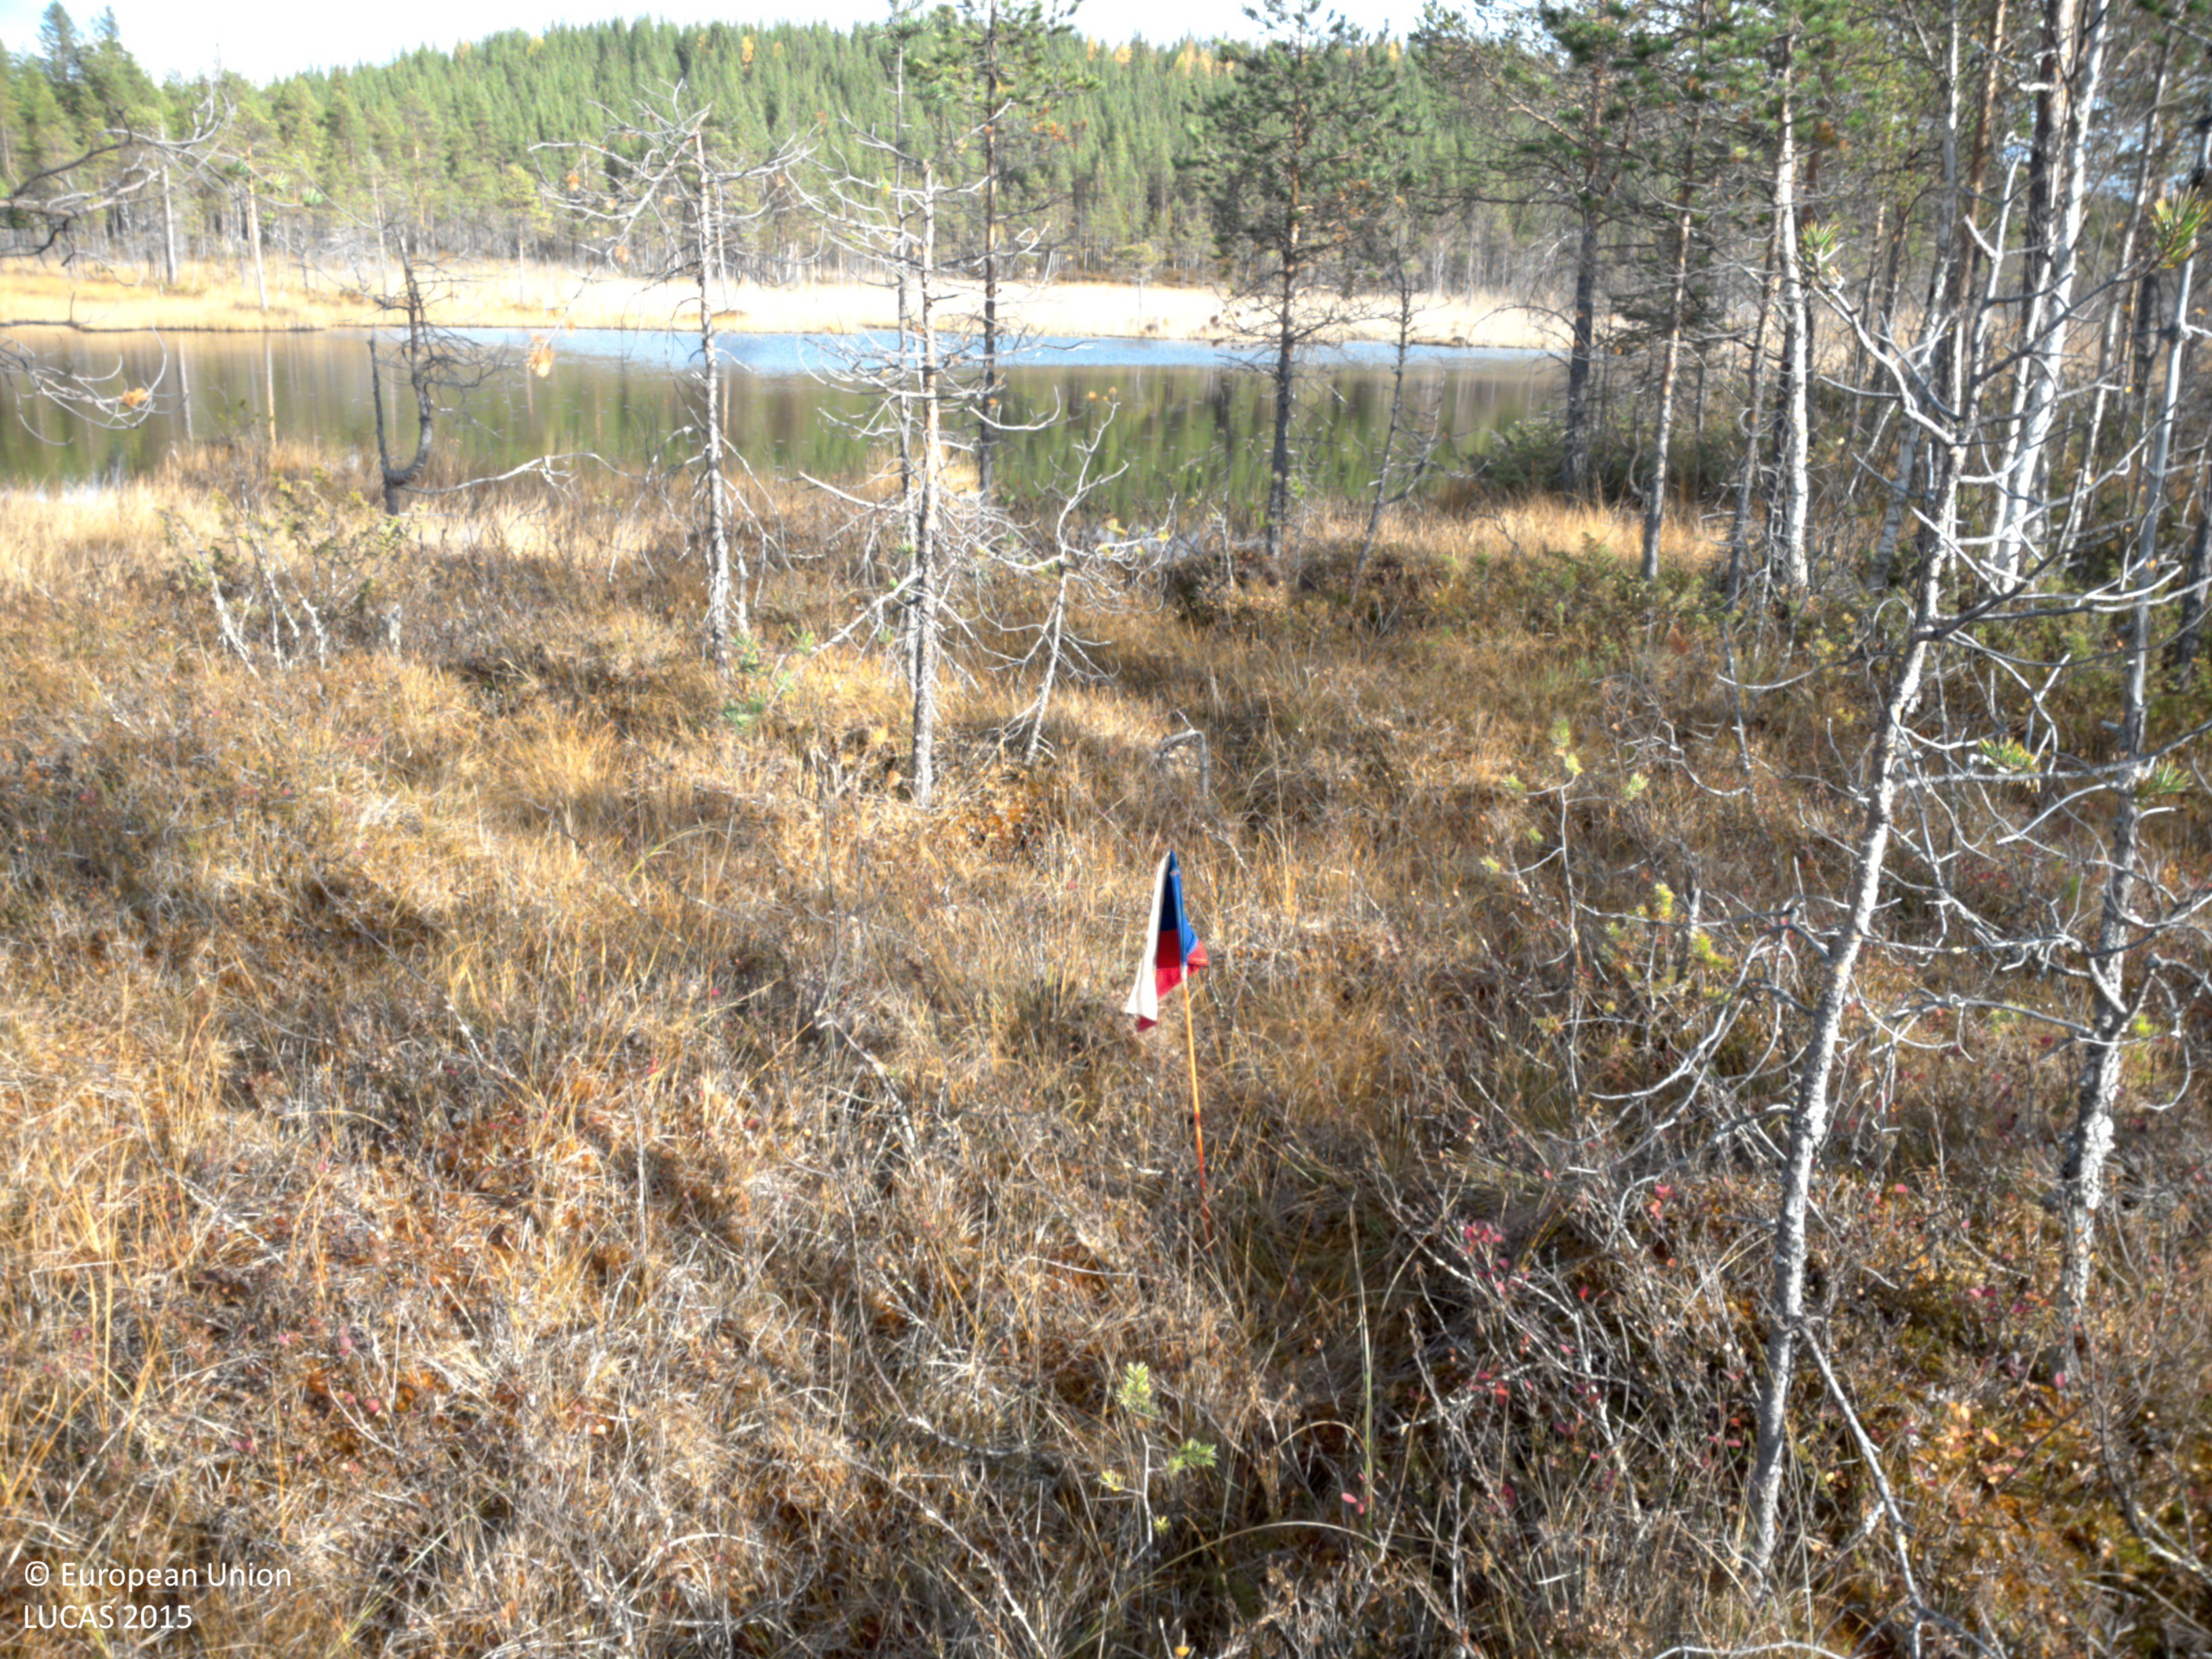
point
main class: Woodland
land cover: Pine dominated coniferous woodland
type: boreal forest
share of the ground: 25 - 50 %
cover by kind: coniferous forest trees 40 %, shrubs 20 %, herbaceous plants 20 %, broadleaved forest trees 10 %, lichens and mosses 10 %
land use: Semi-natural and natural areas not in use
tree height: < 5 m
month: September
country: SE
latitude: 64.8763
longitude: 18.5568
